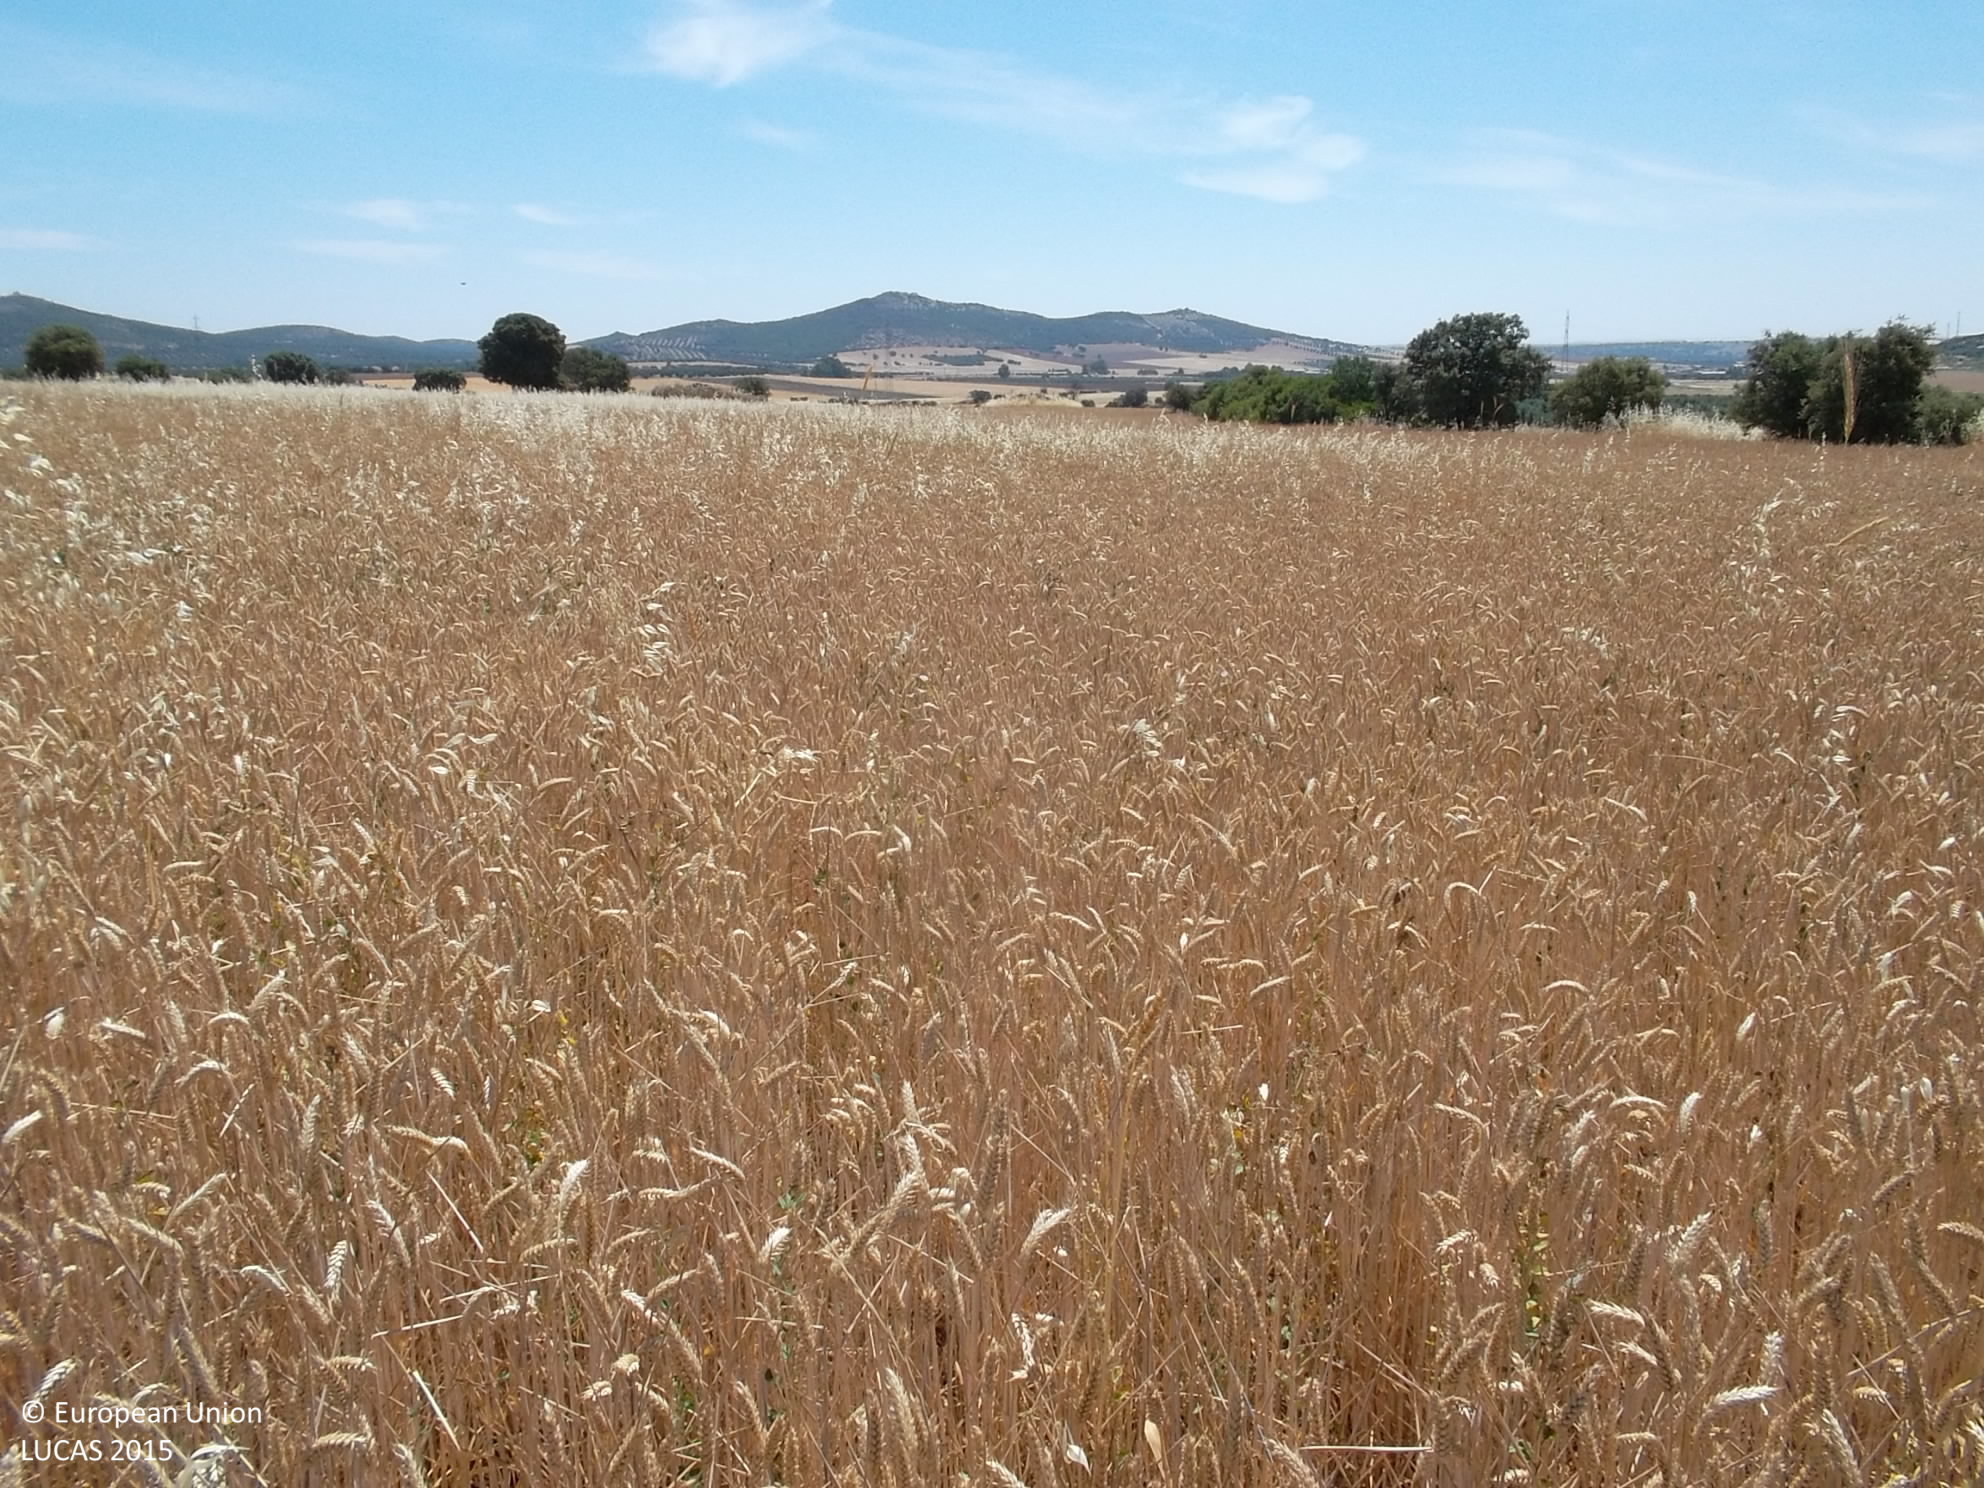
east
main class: Cropland
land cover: Common wheat
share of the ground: > 75 %
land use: Agriculture (excluding fallow land and kitchen gardens)
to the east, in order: Common wheat; Rock outcrops; Common wheat
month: June
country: ES
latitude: 39.0617
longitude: -4.0882
